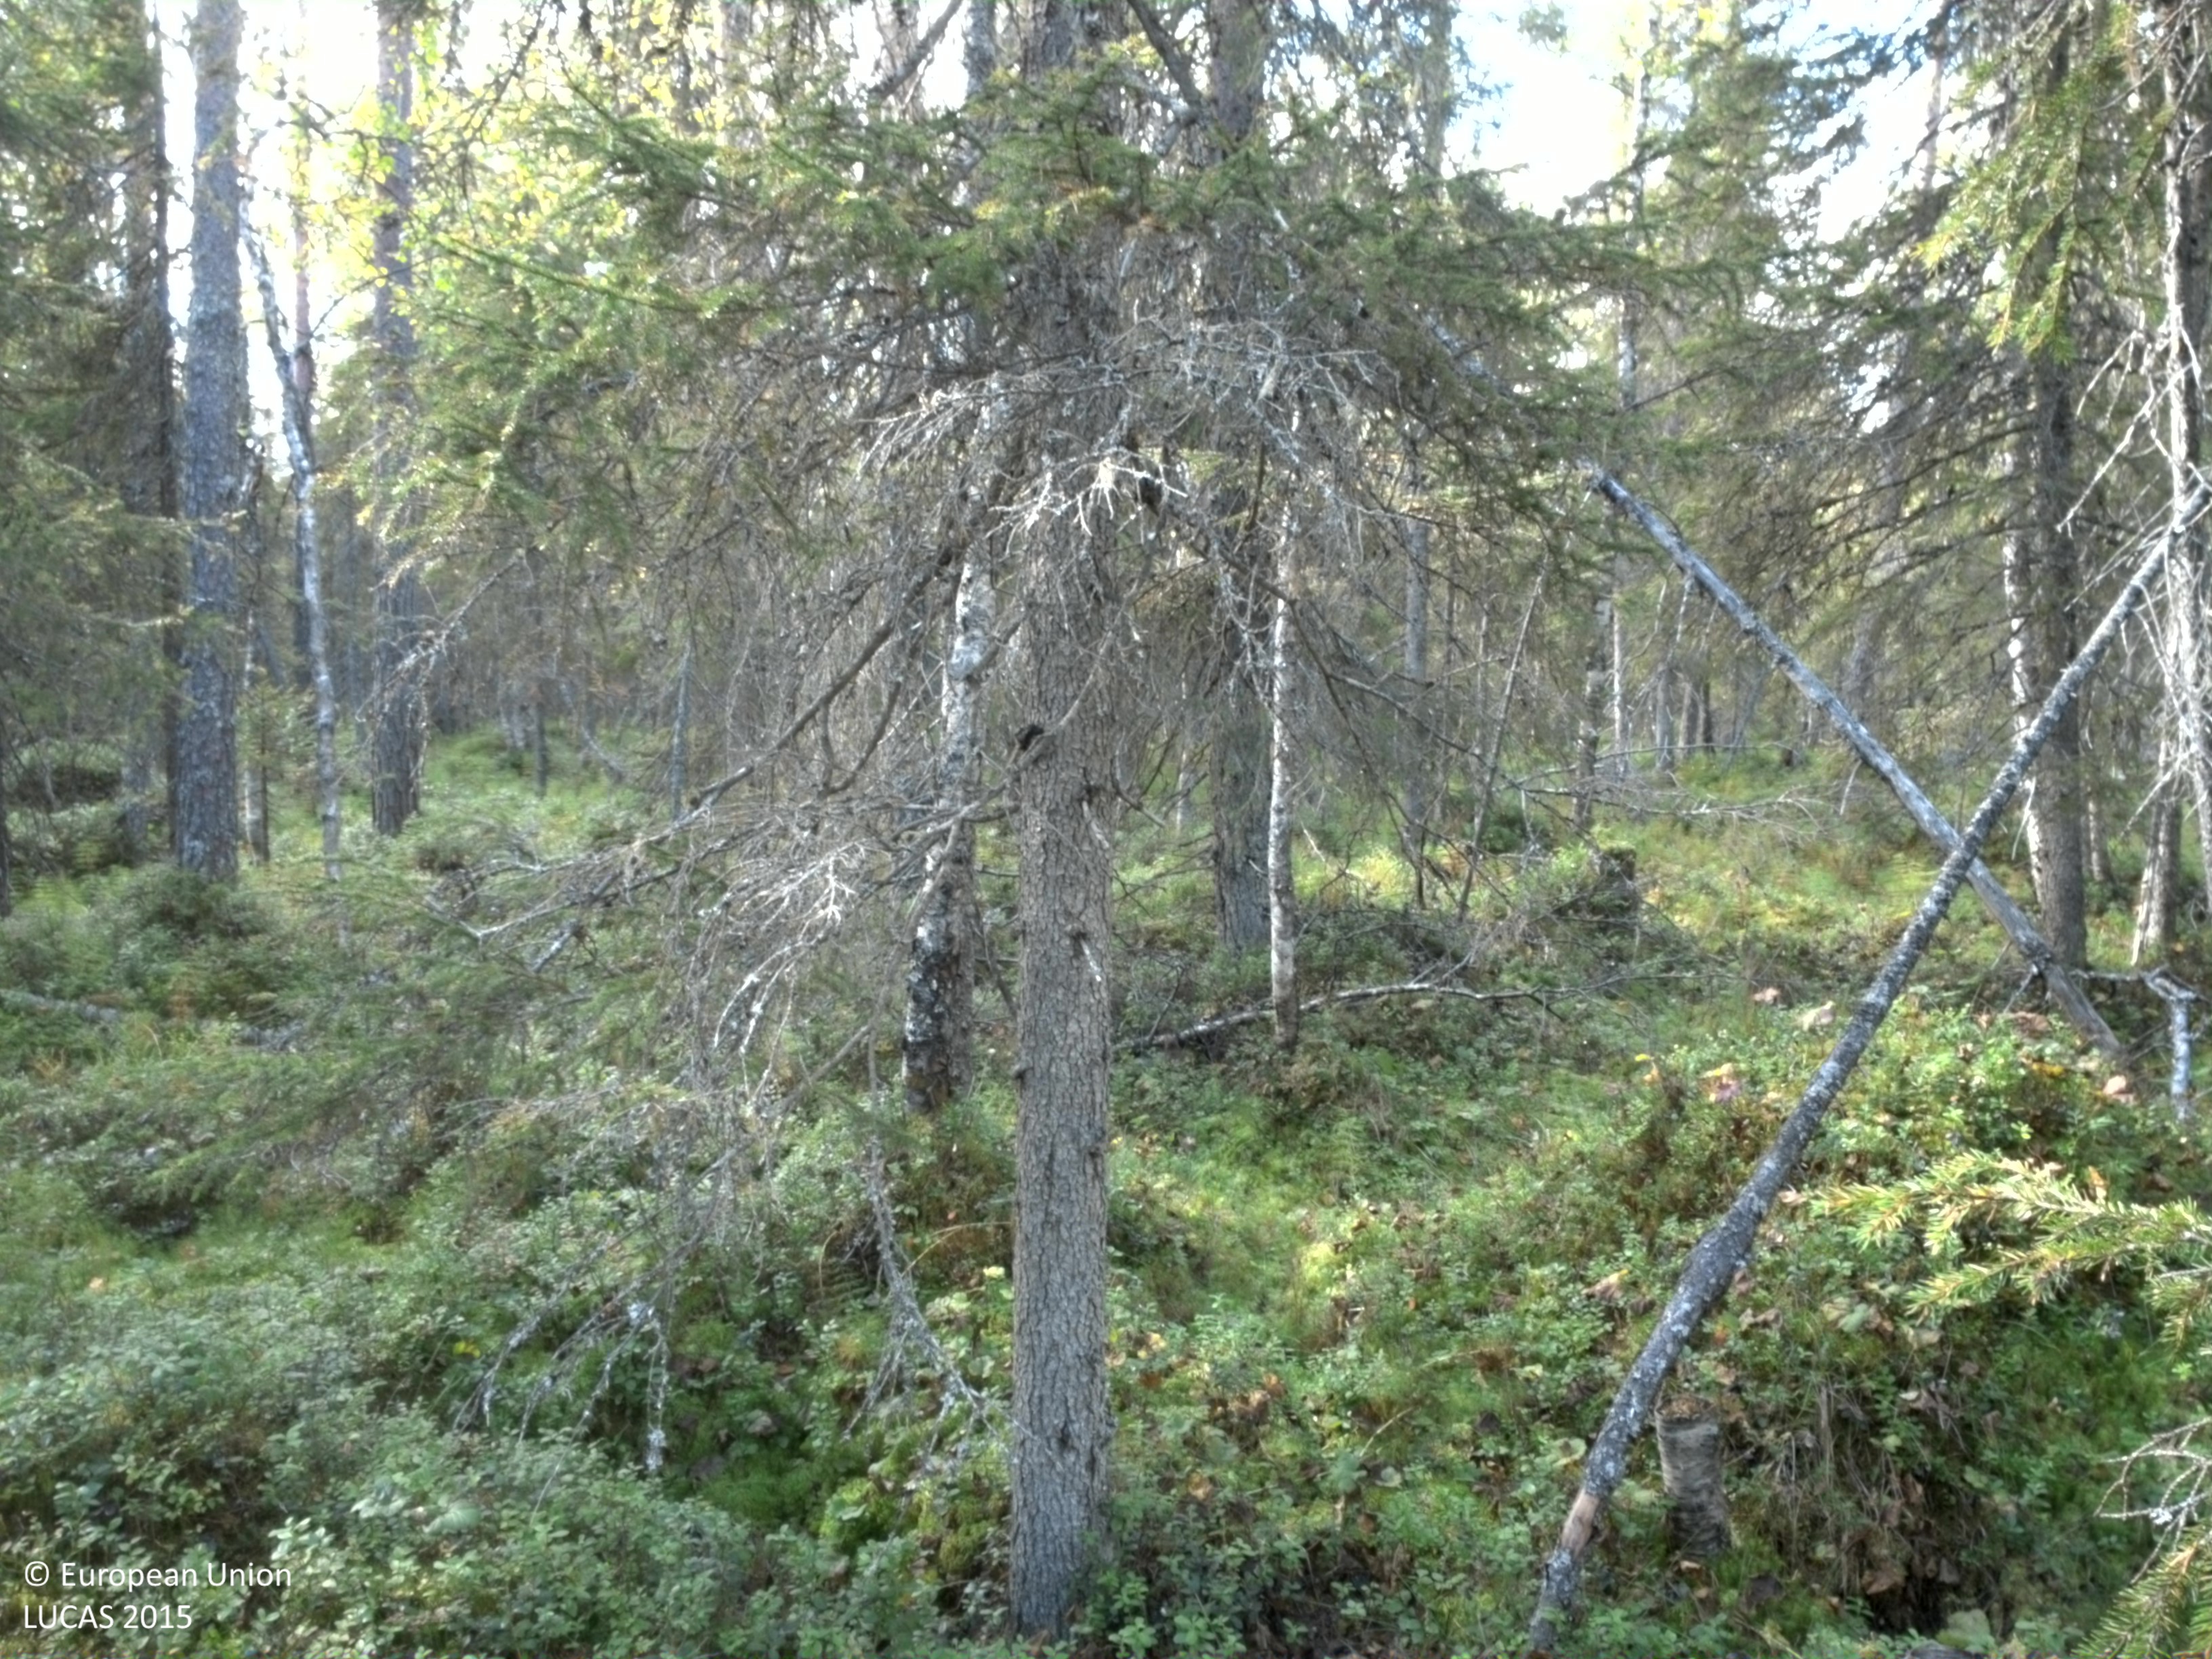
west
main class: Woodland
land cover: Spruce dominated coniferous woodland
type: boreal forest
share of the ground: 50 - 75 %
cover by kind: shrubs 45 %, coniferous forest trees 40 %, broadleaved forest trees 10 %, lichens and mosses 5 %
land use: Forestry
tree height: > 5 m
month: September
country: SE
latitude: 66.1335
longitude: 23.0735
